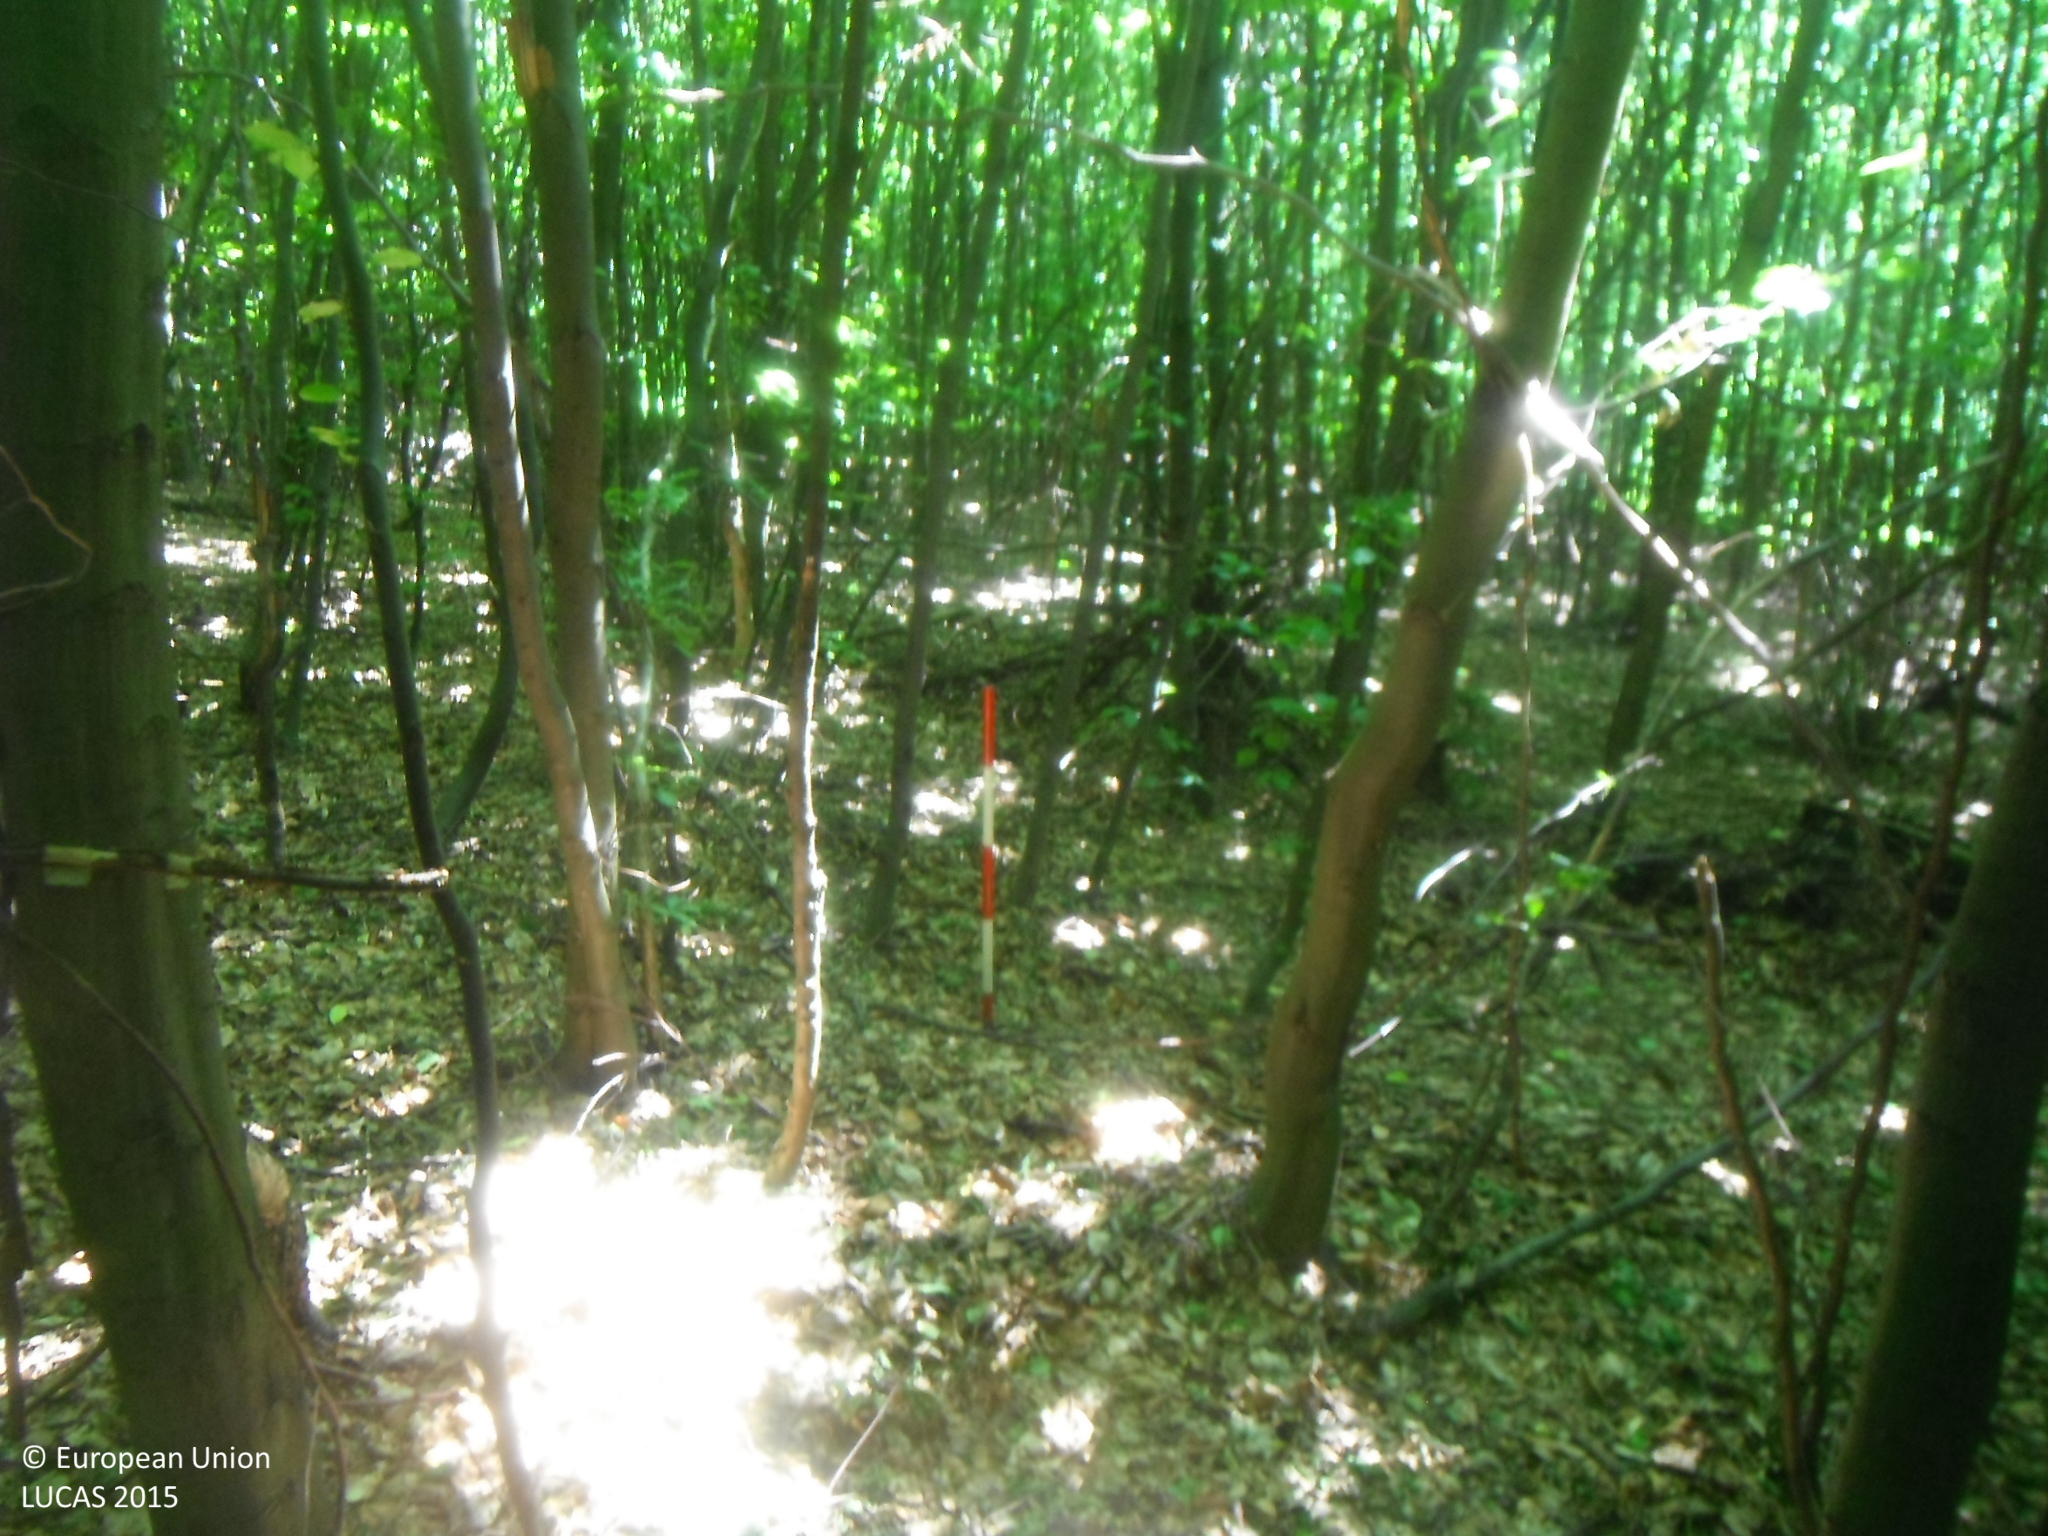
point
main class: Woodland
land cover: Broadleaved woodland
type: beech forest
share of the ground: > 75 %
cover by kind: broadleaved forest trees 95 %, herbaceous plants 5 %
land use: Forestry
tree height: > 5 m
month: June
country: SK
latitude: 49.0287
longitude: 21.5790
